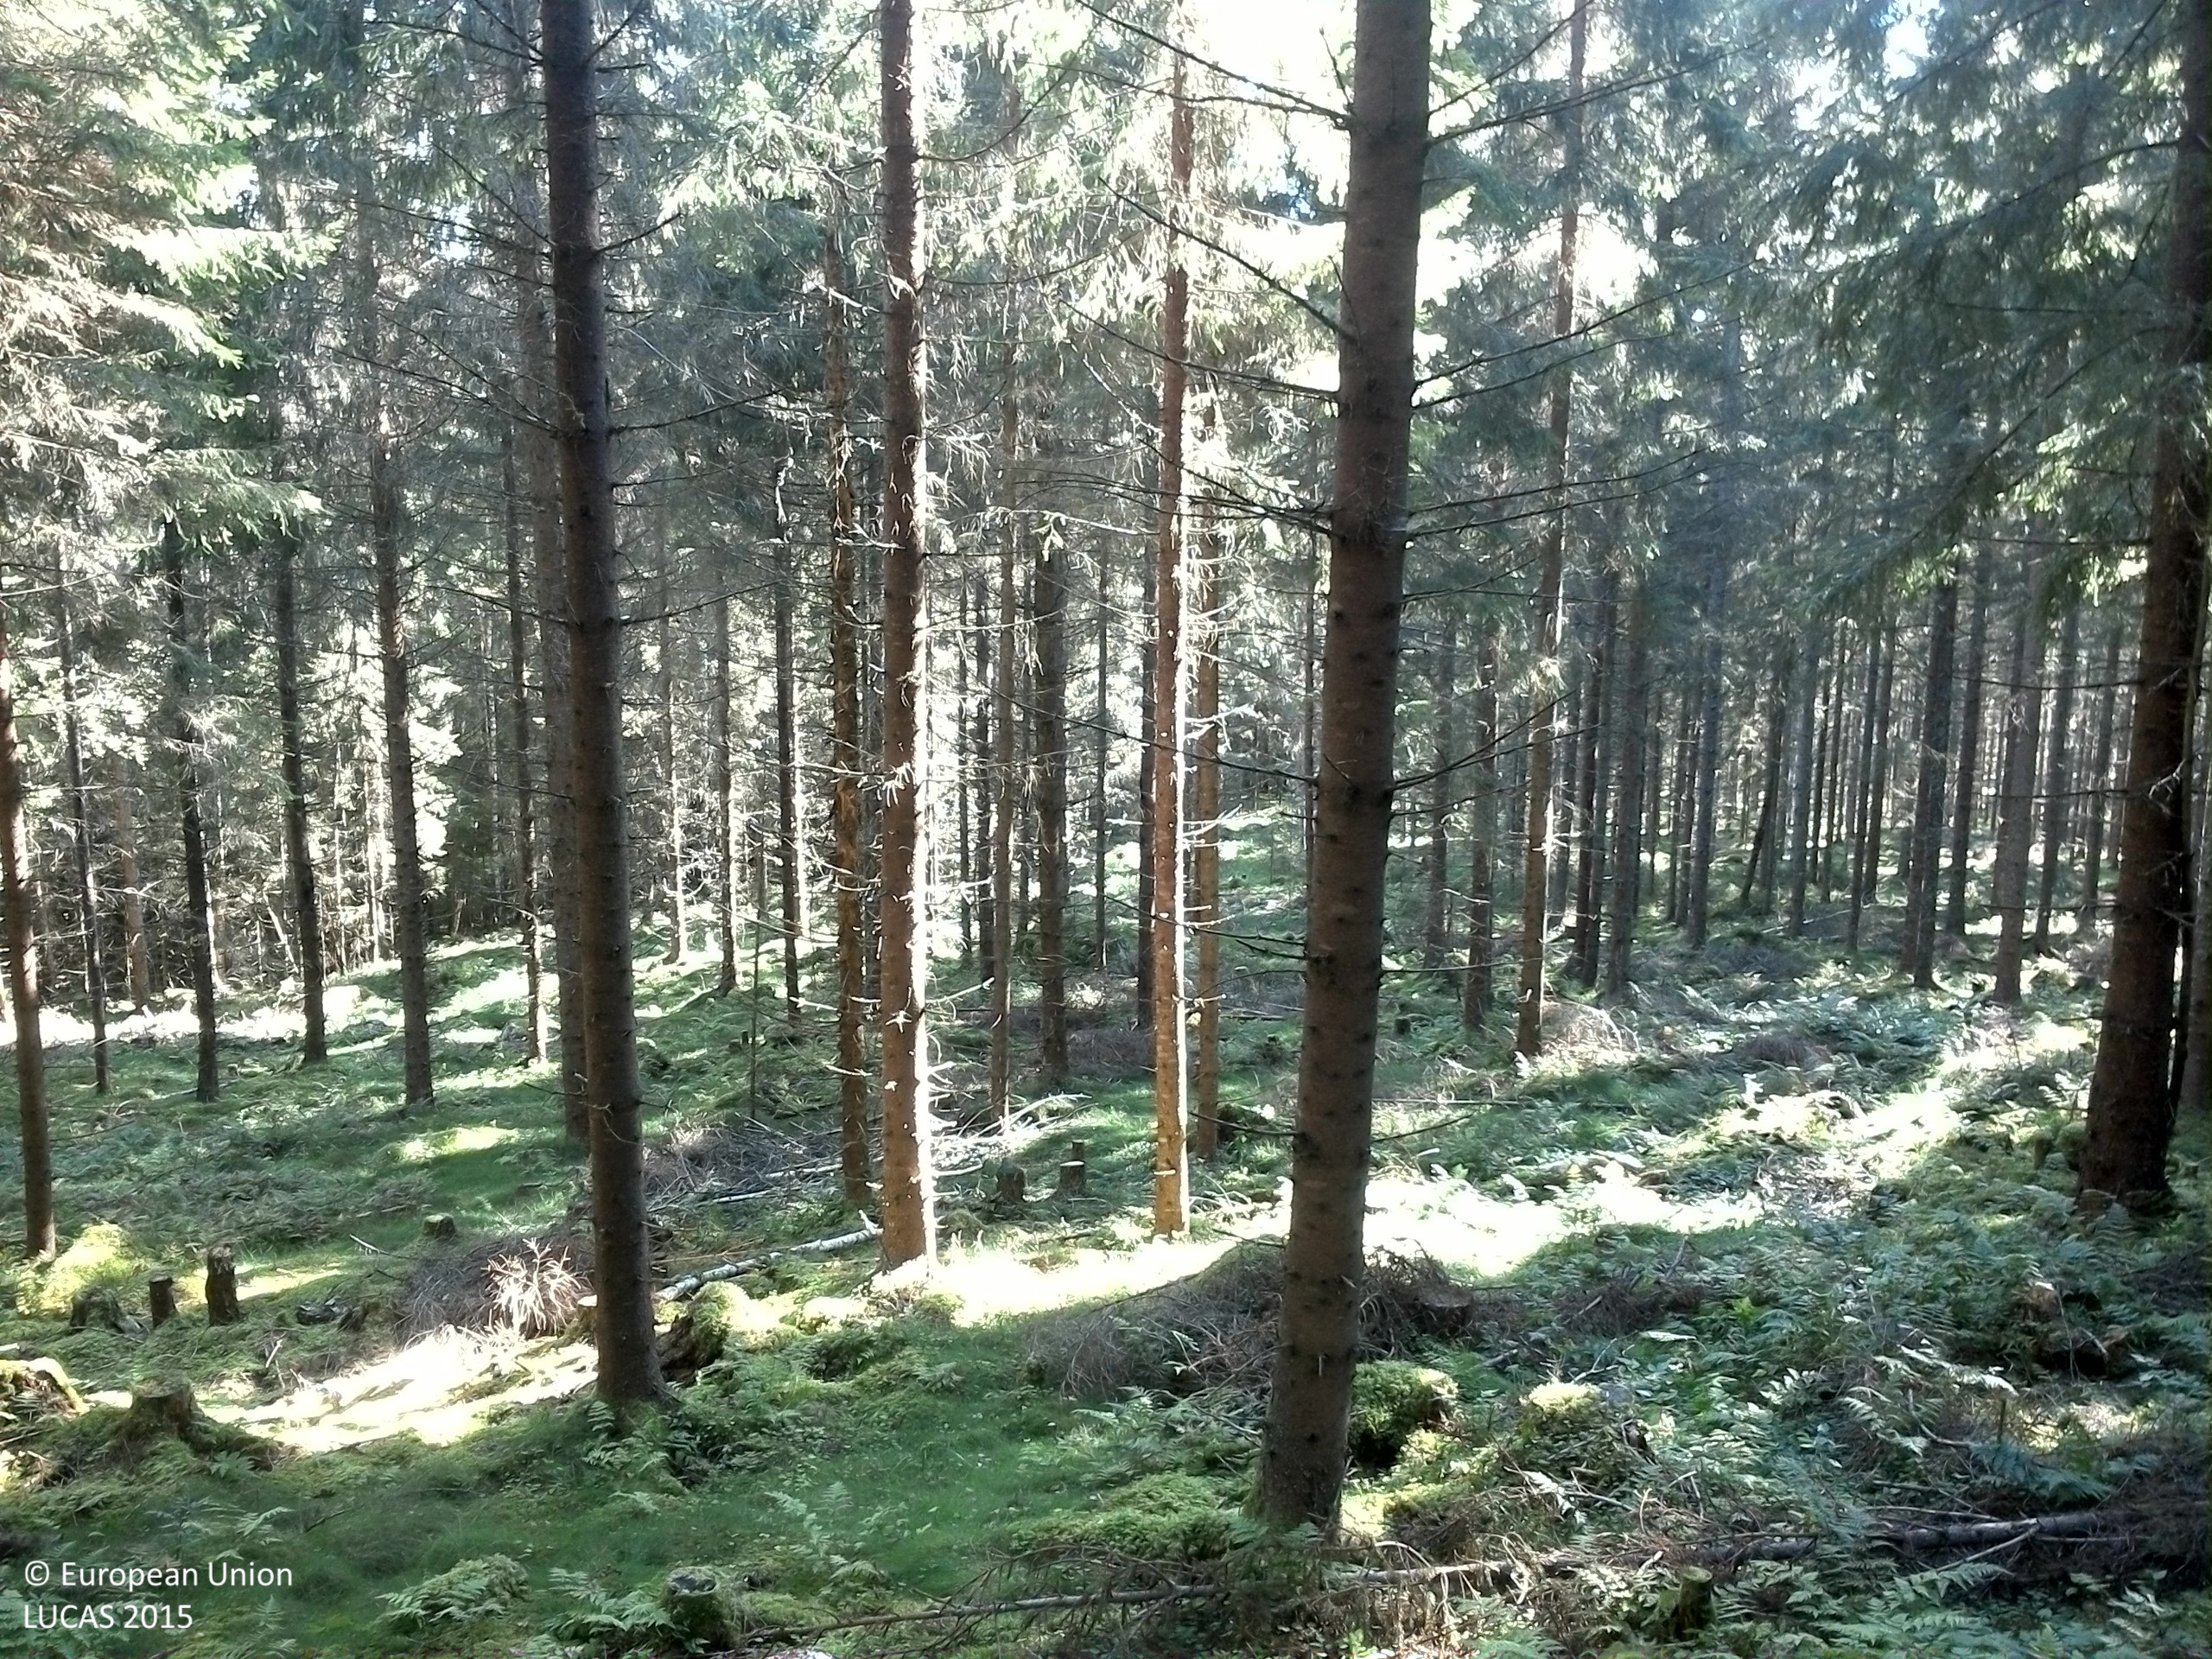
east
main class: Woodland
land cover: Spruce dominated coniferous woodland
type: boreal forest
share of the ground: 50 - 75 %
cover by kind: coniferous forest trees 70 %, lichens and mosses 15 %, shrubs 10 %, herbaceous plants 5 %
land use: Forestry
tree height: > 5 m
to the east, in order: Spruce dominated coniferous woodland; Tracks; Spruce dominated coniferous woodland
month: September
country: SE
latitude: 59.8667
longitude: 13.5092
